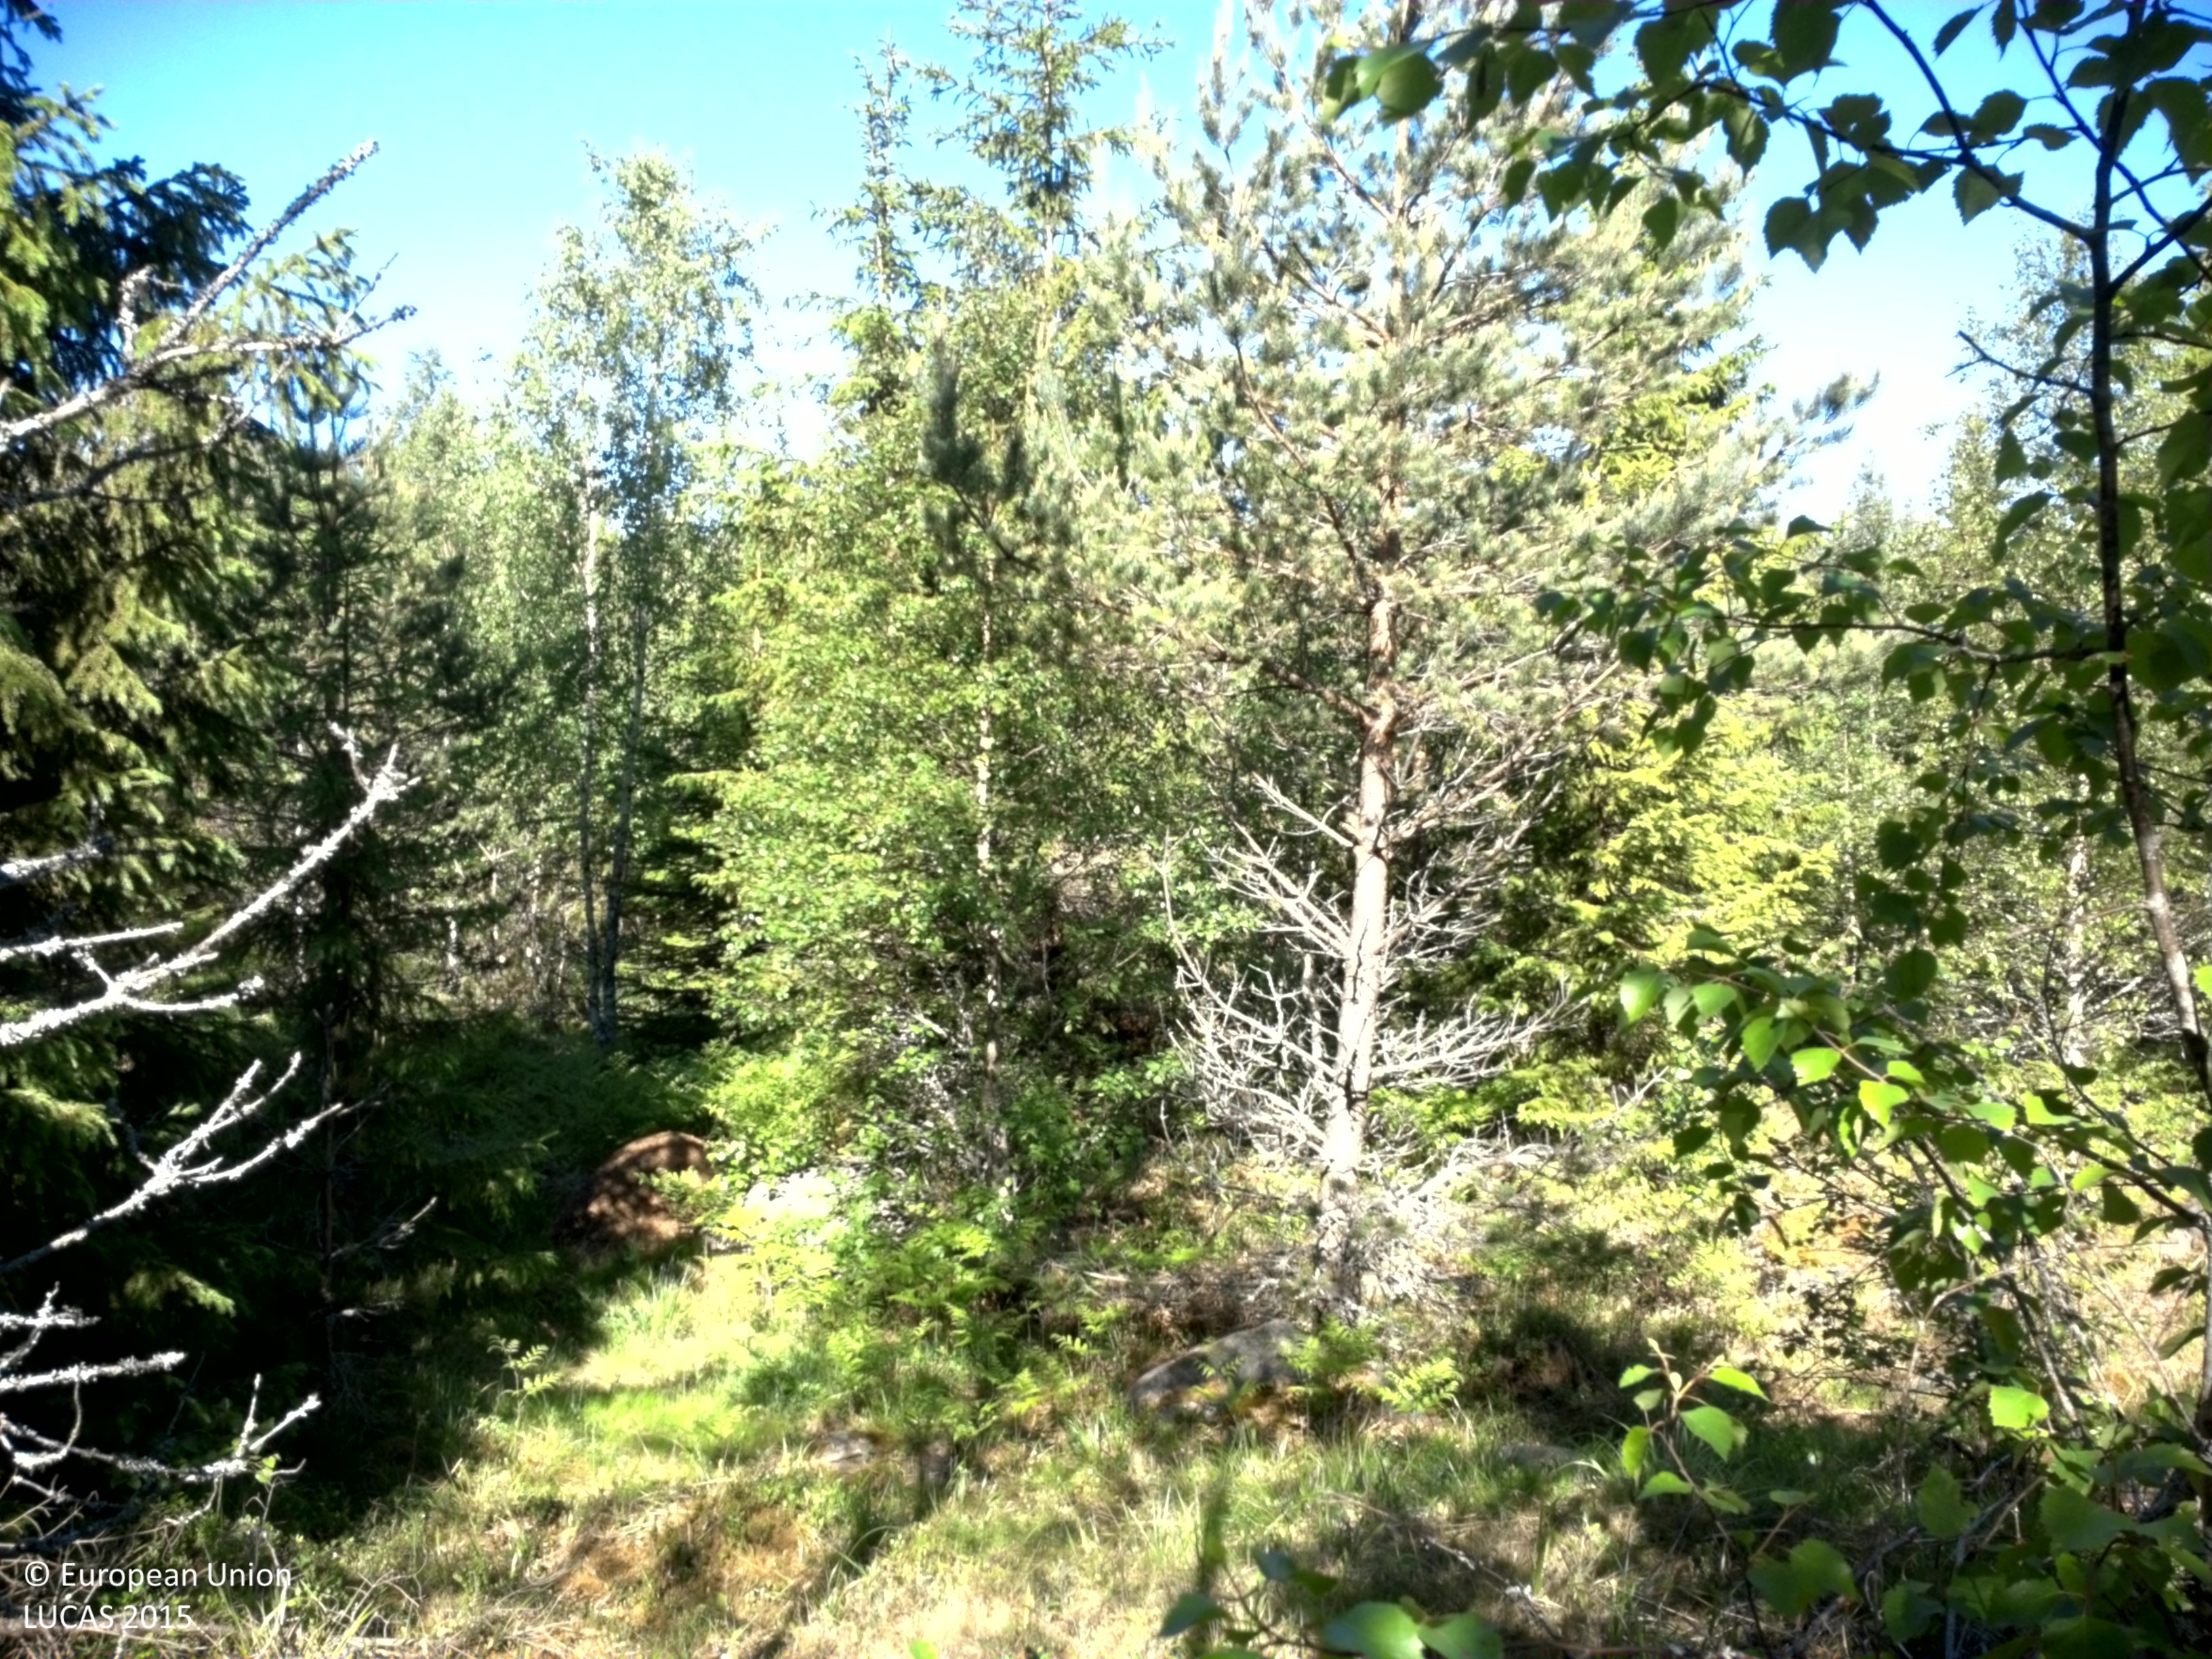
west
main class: Woodland
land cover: Other coniferous woodland
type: boreal forest
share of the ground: 50 - 75 %
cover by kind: coniferous forest trees 40 %, herbaceous plants 25 %, lichens and mosses 25 %, broadleaved forest trees 10 %
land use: Forestry
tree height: > 5 m
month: June
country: SE
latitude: 60.2142
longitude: 17.1920
